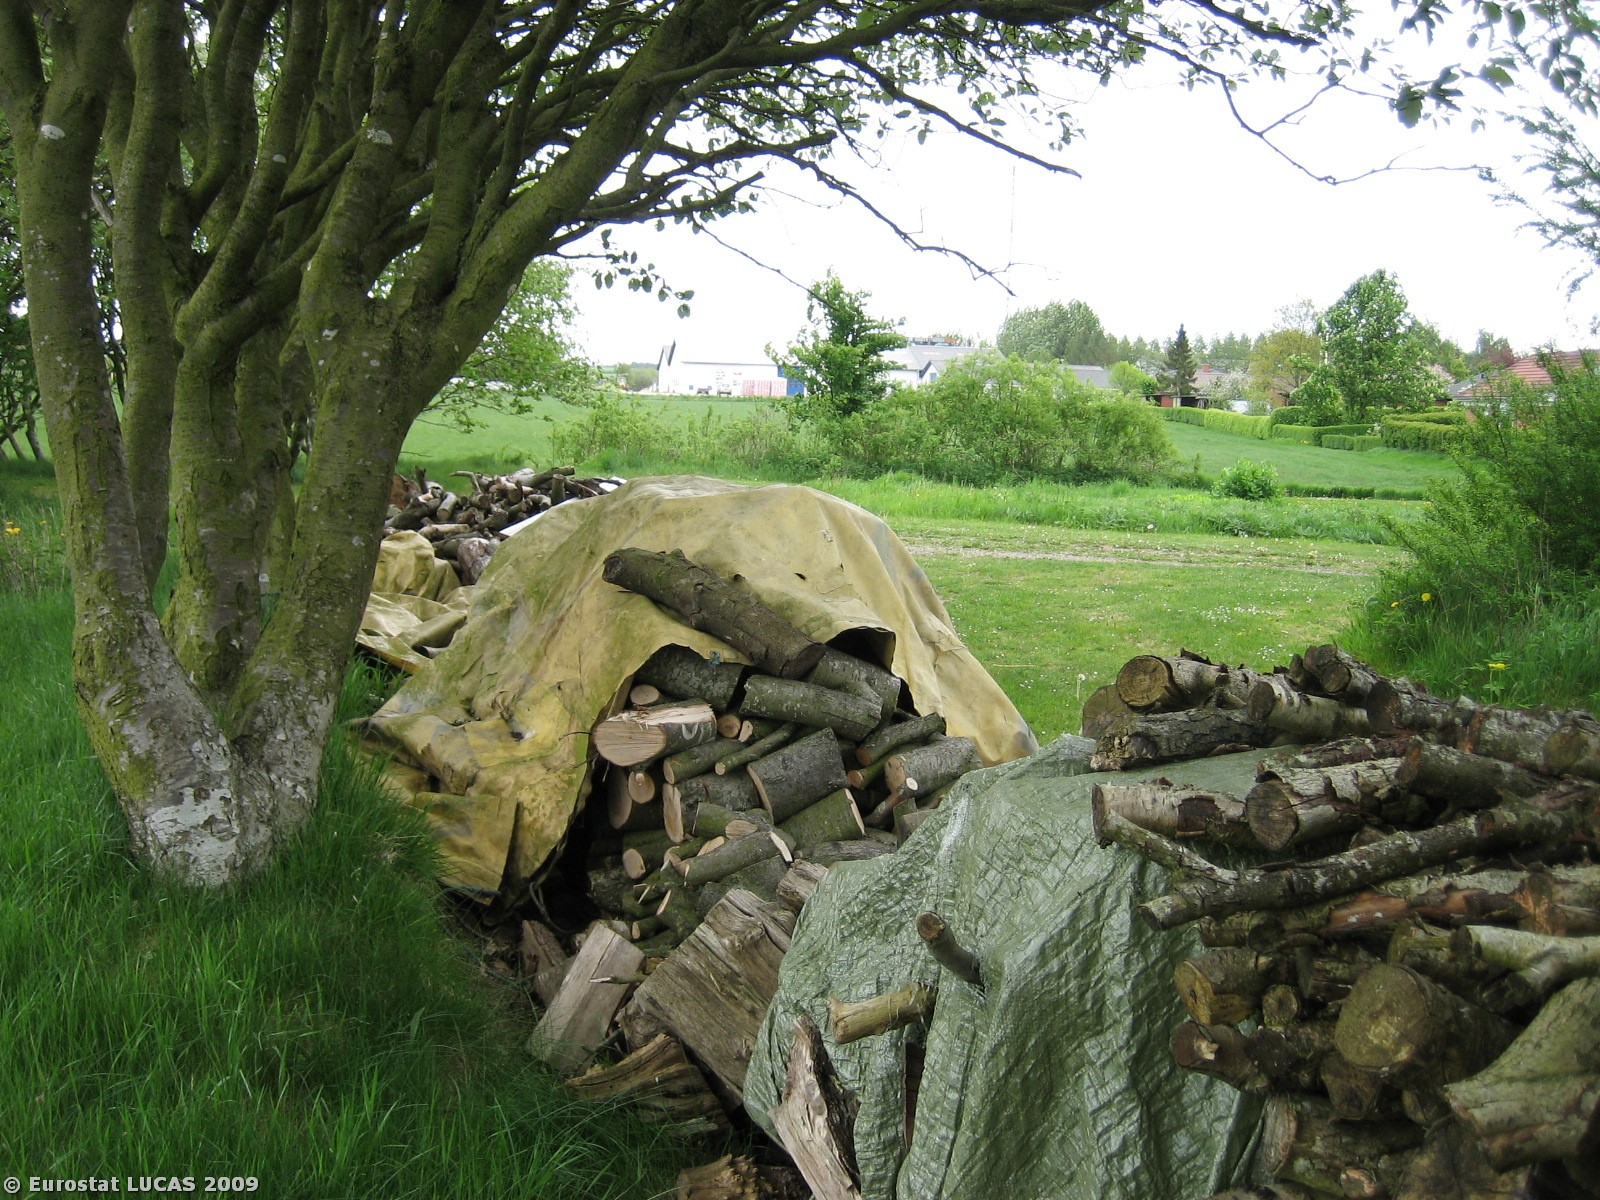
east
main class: Woodland
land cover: Broadleaved woodland
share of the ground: 50 - 75 %
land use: Unused
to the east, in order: Broadleaved woodland; Tracks; Broadleaved woodland; Grassland without tree/shrub cover; Grass margins; Paved roads, cycling and walking lanes; Grass margins; Grassland without tree/shrub cover
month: May
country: DK
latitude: 56.1794
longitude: 8.5357
